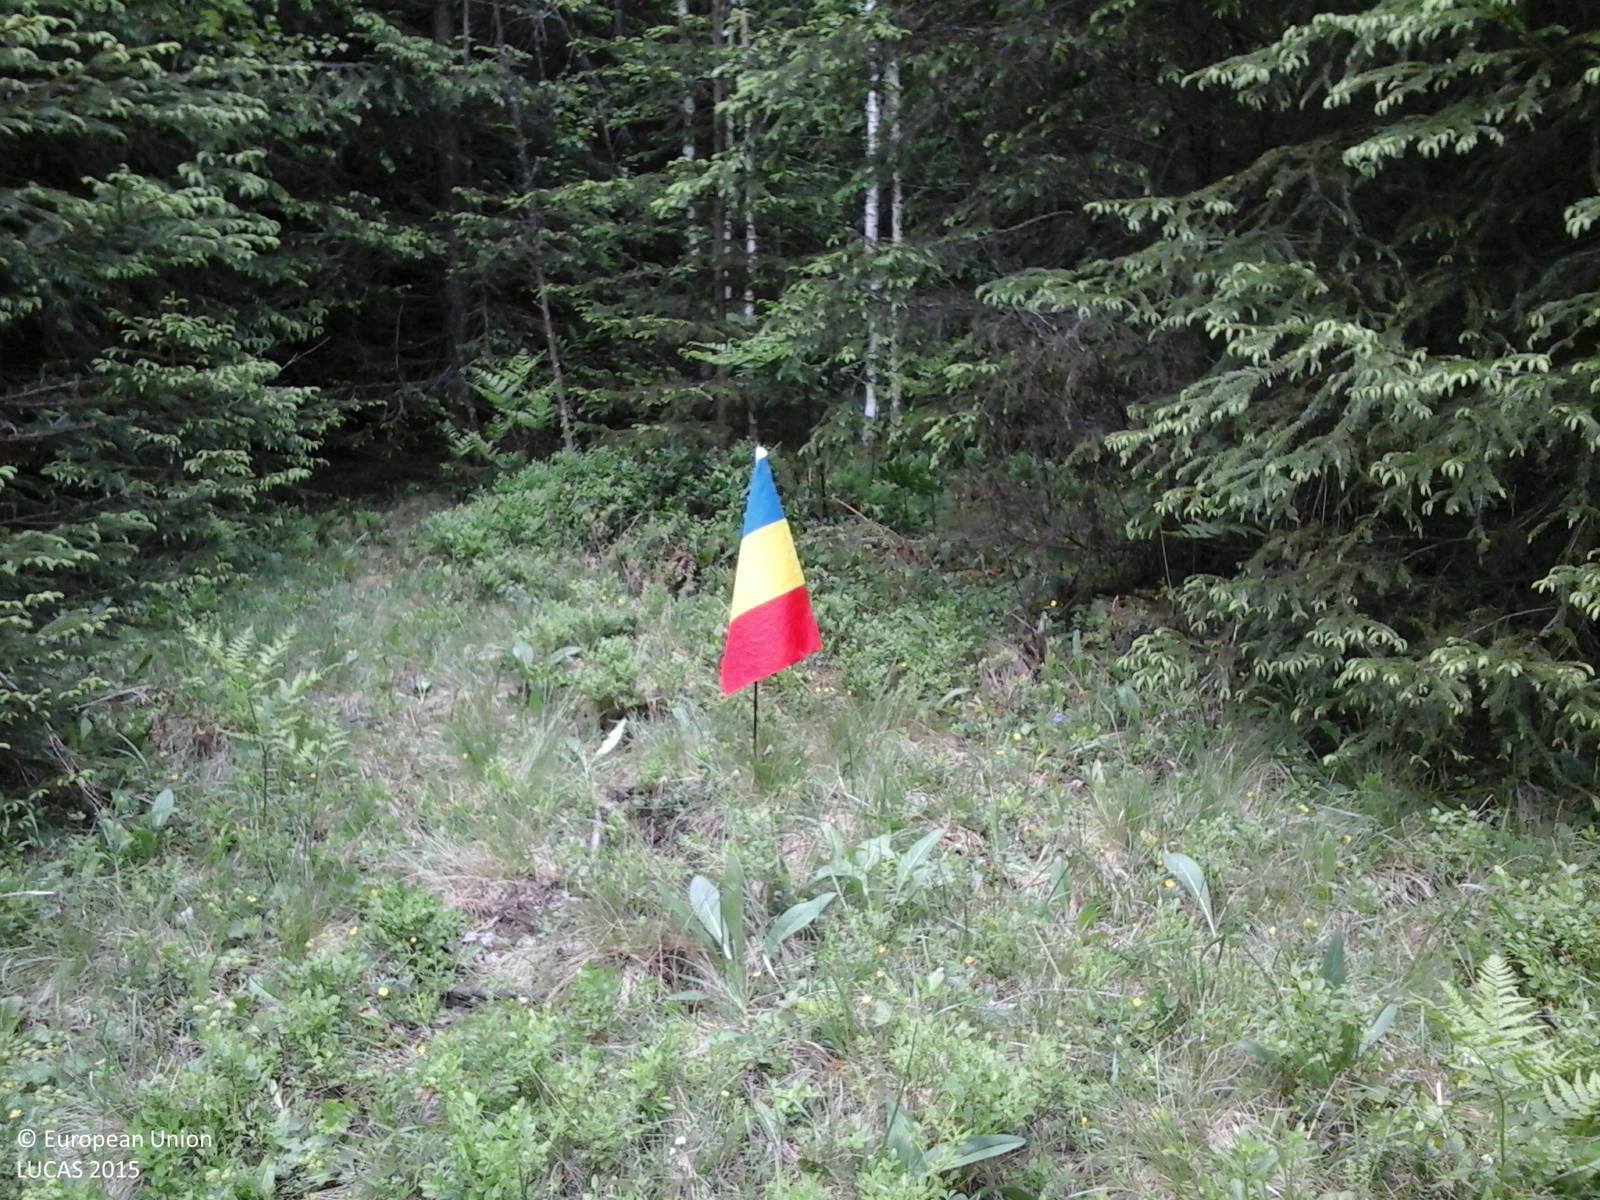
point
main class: Woodland
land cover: Spruce dominated coniferous woodland
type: alpine coniferous forest
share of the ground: > 75 %
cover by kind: coniferous forest trees 100 %
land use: Forestry
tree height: > 5 m
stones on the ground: 25 - 50 %
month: June
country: RO
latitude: 47.4763
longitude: 25.3045
